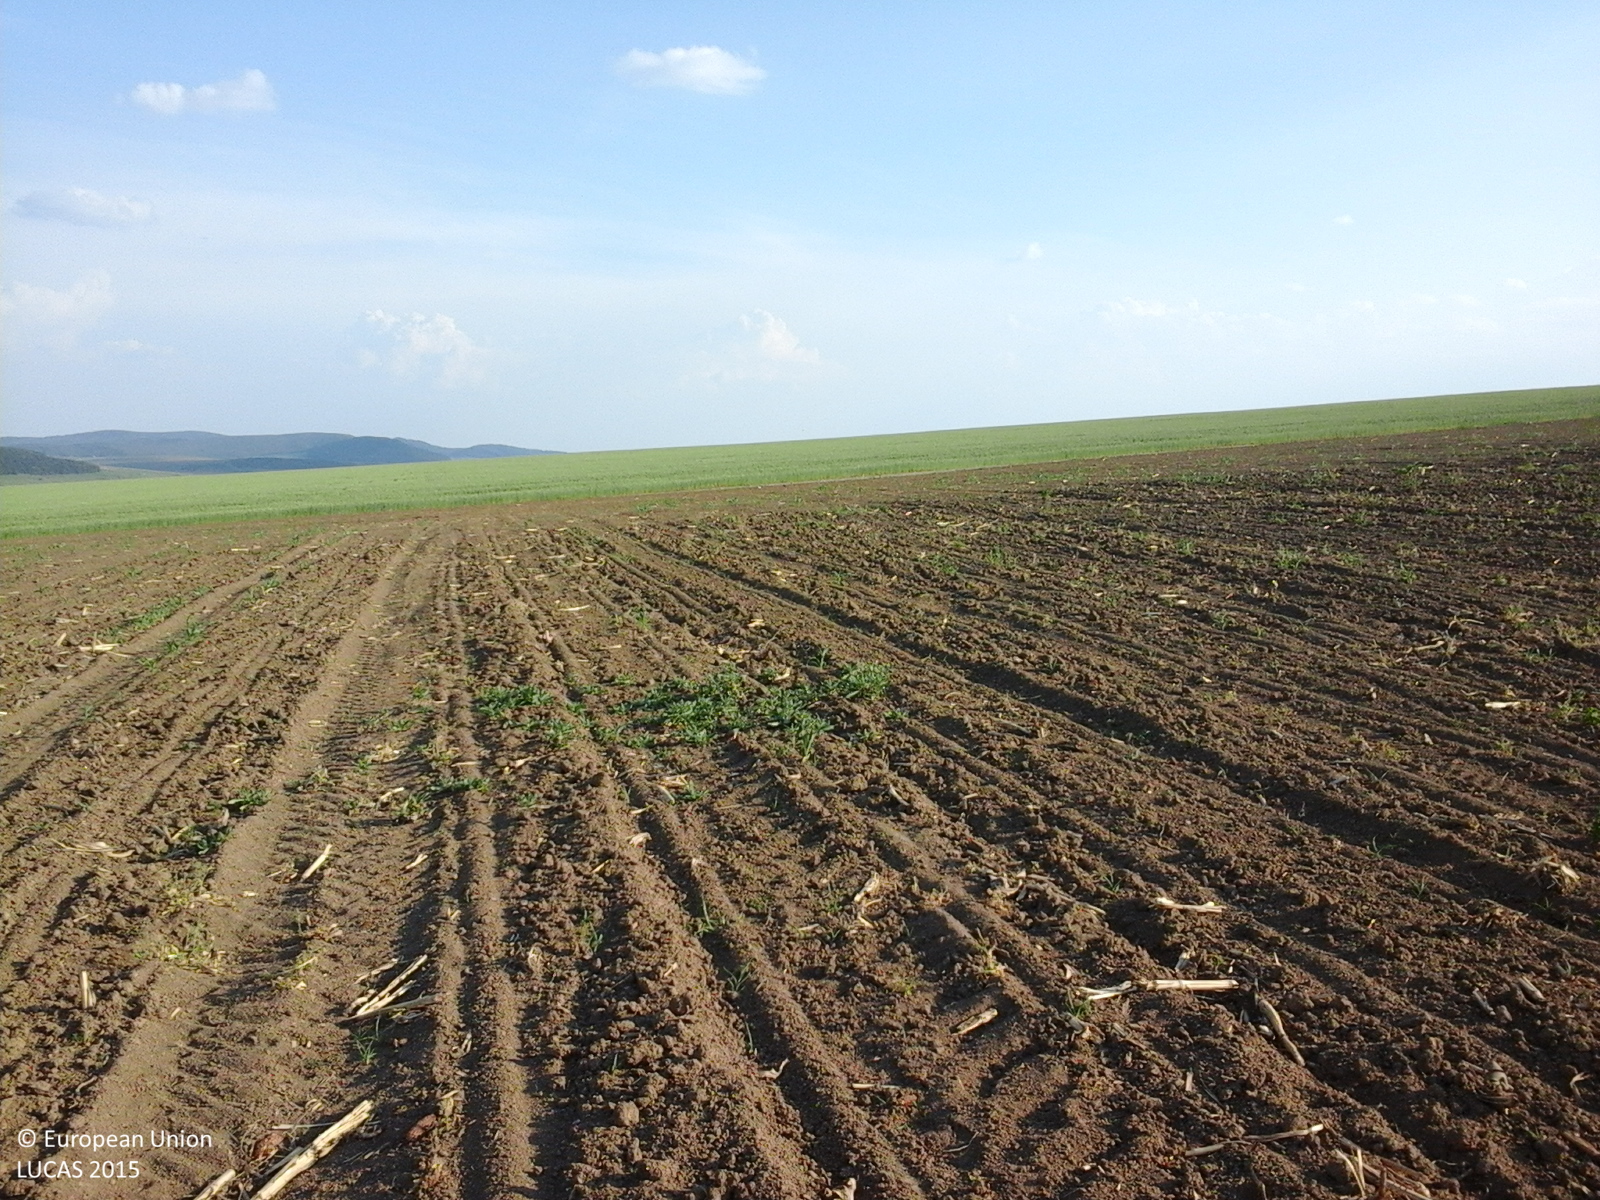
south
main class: Cropland
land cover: Maize
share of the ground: < 10 %
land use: Agriculture (excluding fallow land and kitchen gardens)
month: June
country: RO
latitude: 46.8625
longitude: 26.7103
